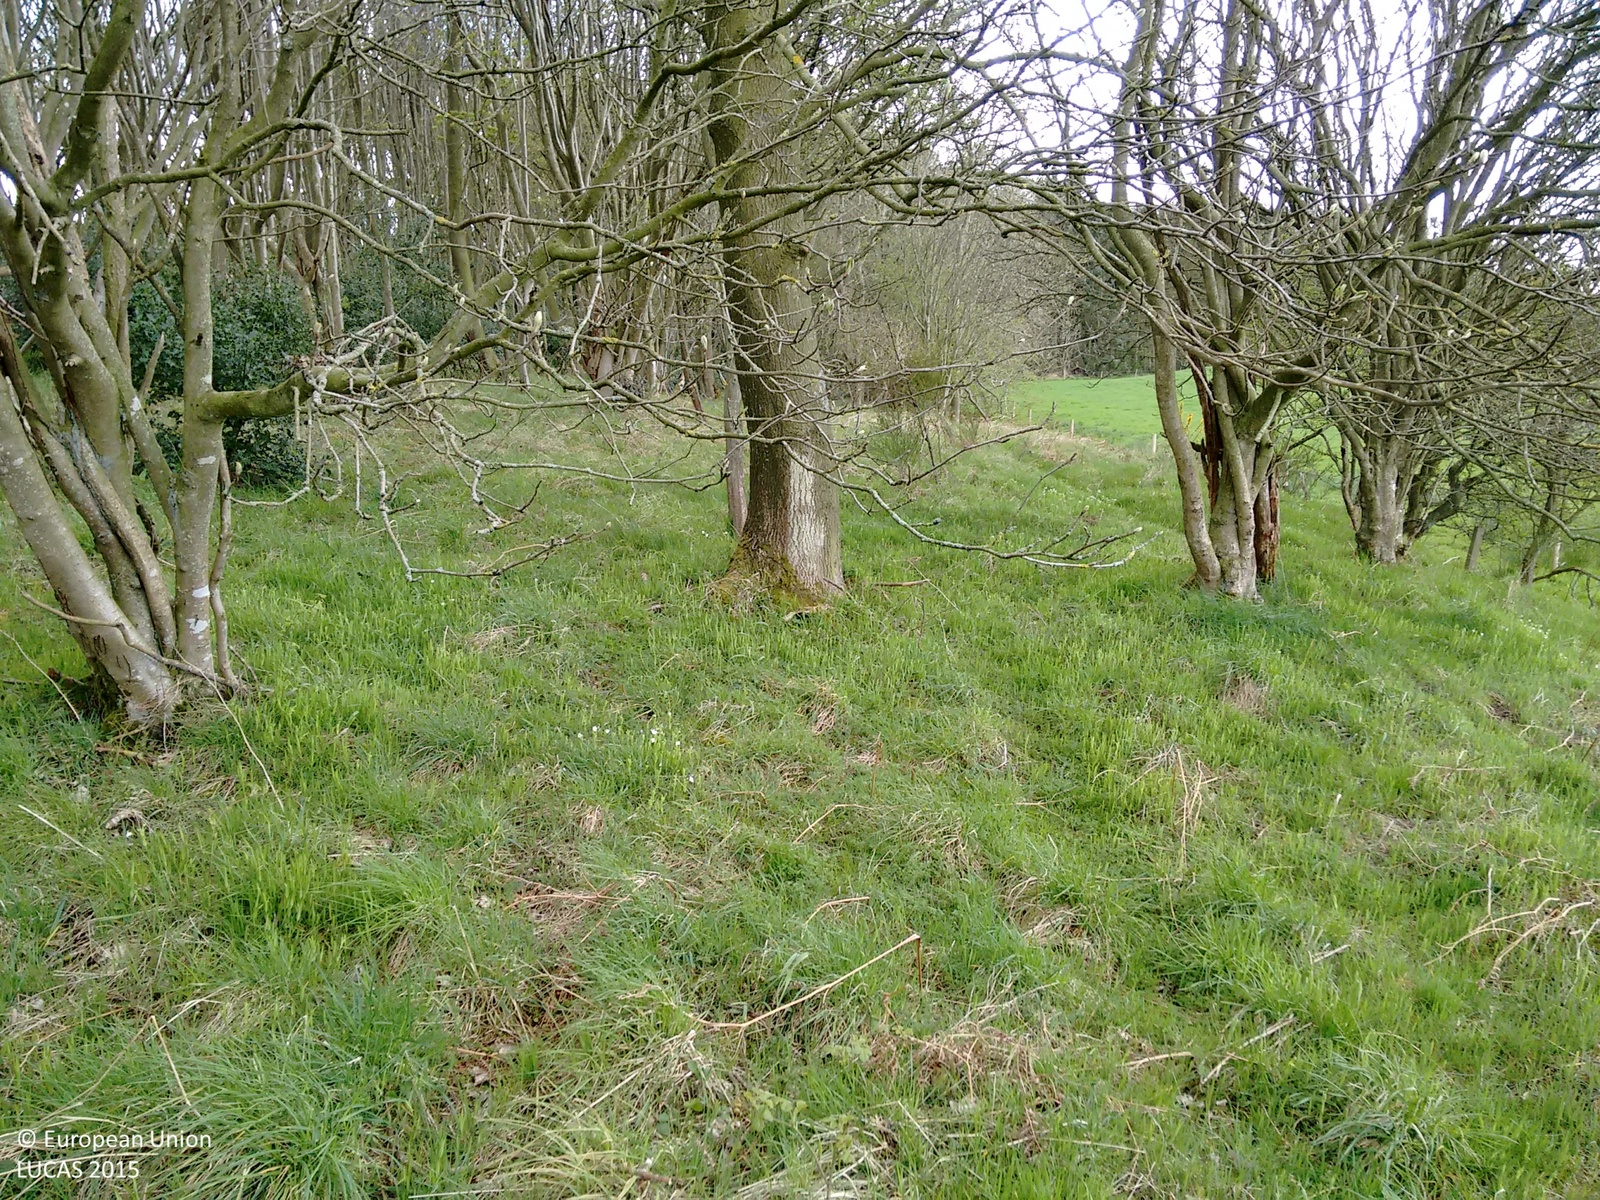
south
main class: Woodland
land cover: Broadleaved woodland
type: acidophilous oak and oak-birch forest
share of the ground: > 75 %
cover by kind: broadleaved forest trees 100 %
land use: Semi-natural and natural areas not in use
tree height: > 5 m
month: May
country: GB
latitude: 54.9077
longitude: -2.0498
